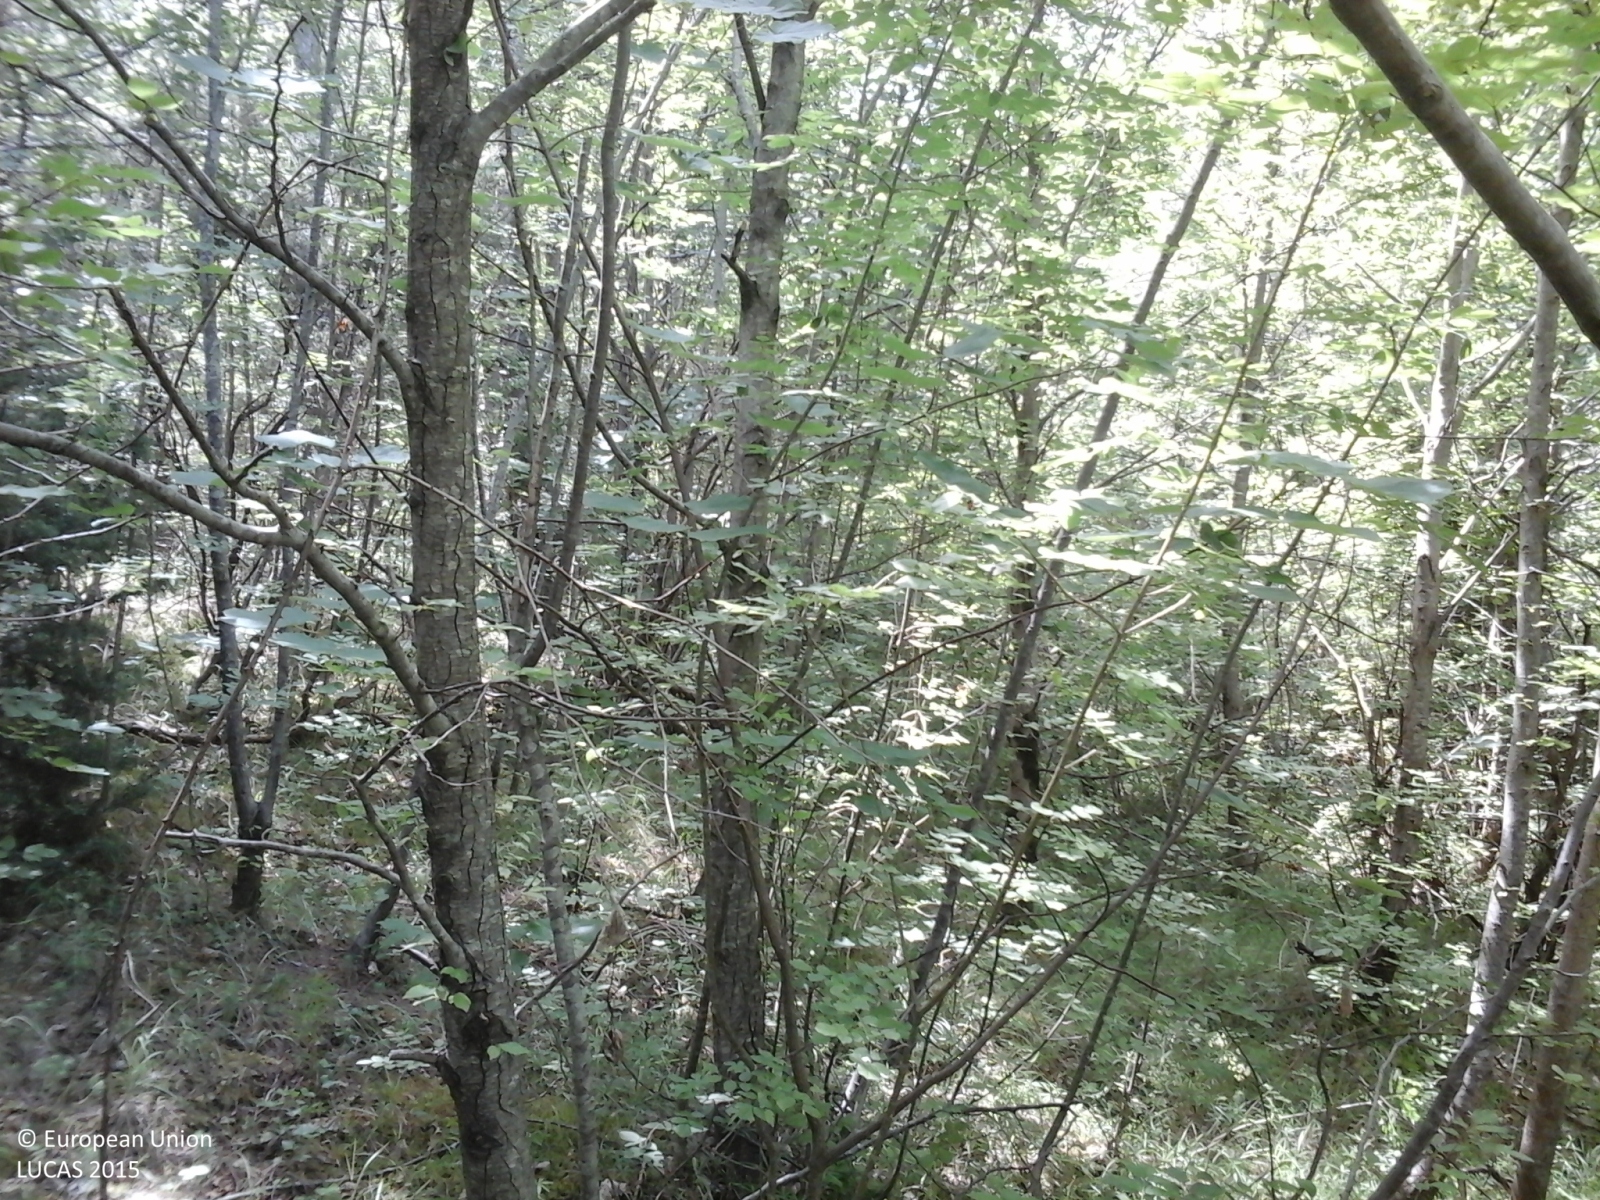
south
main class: Woodland
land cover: Pine dominated mixed woodland
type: thermophilous deciduous forest
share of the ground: > 75 %
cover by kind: broadleaved forest trees 60 %, coniferous forest trees 40 %
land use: Forestry
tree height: > 5 m
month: June
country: IT
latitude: 42.8662
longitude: 13.4541
